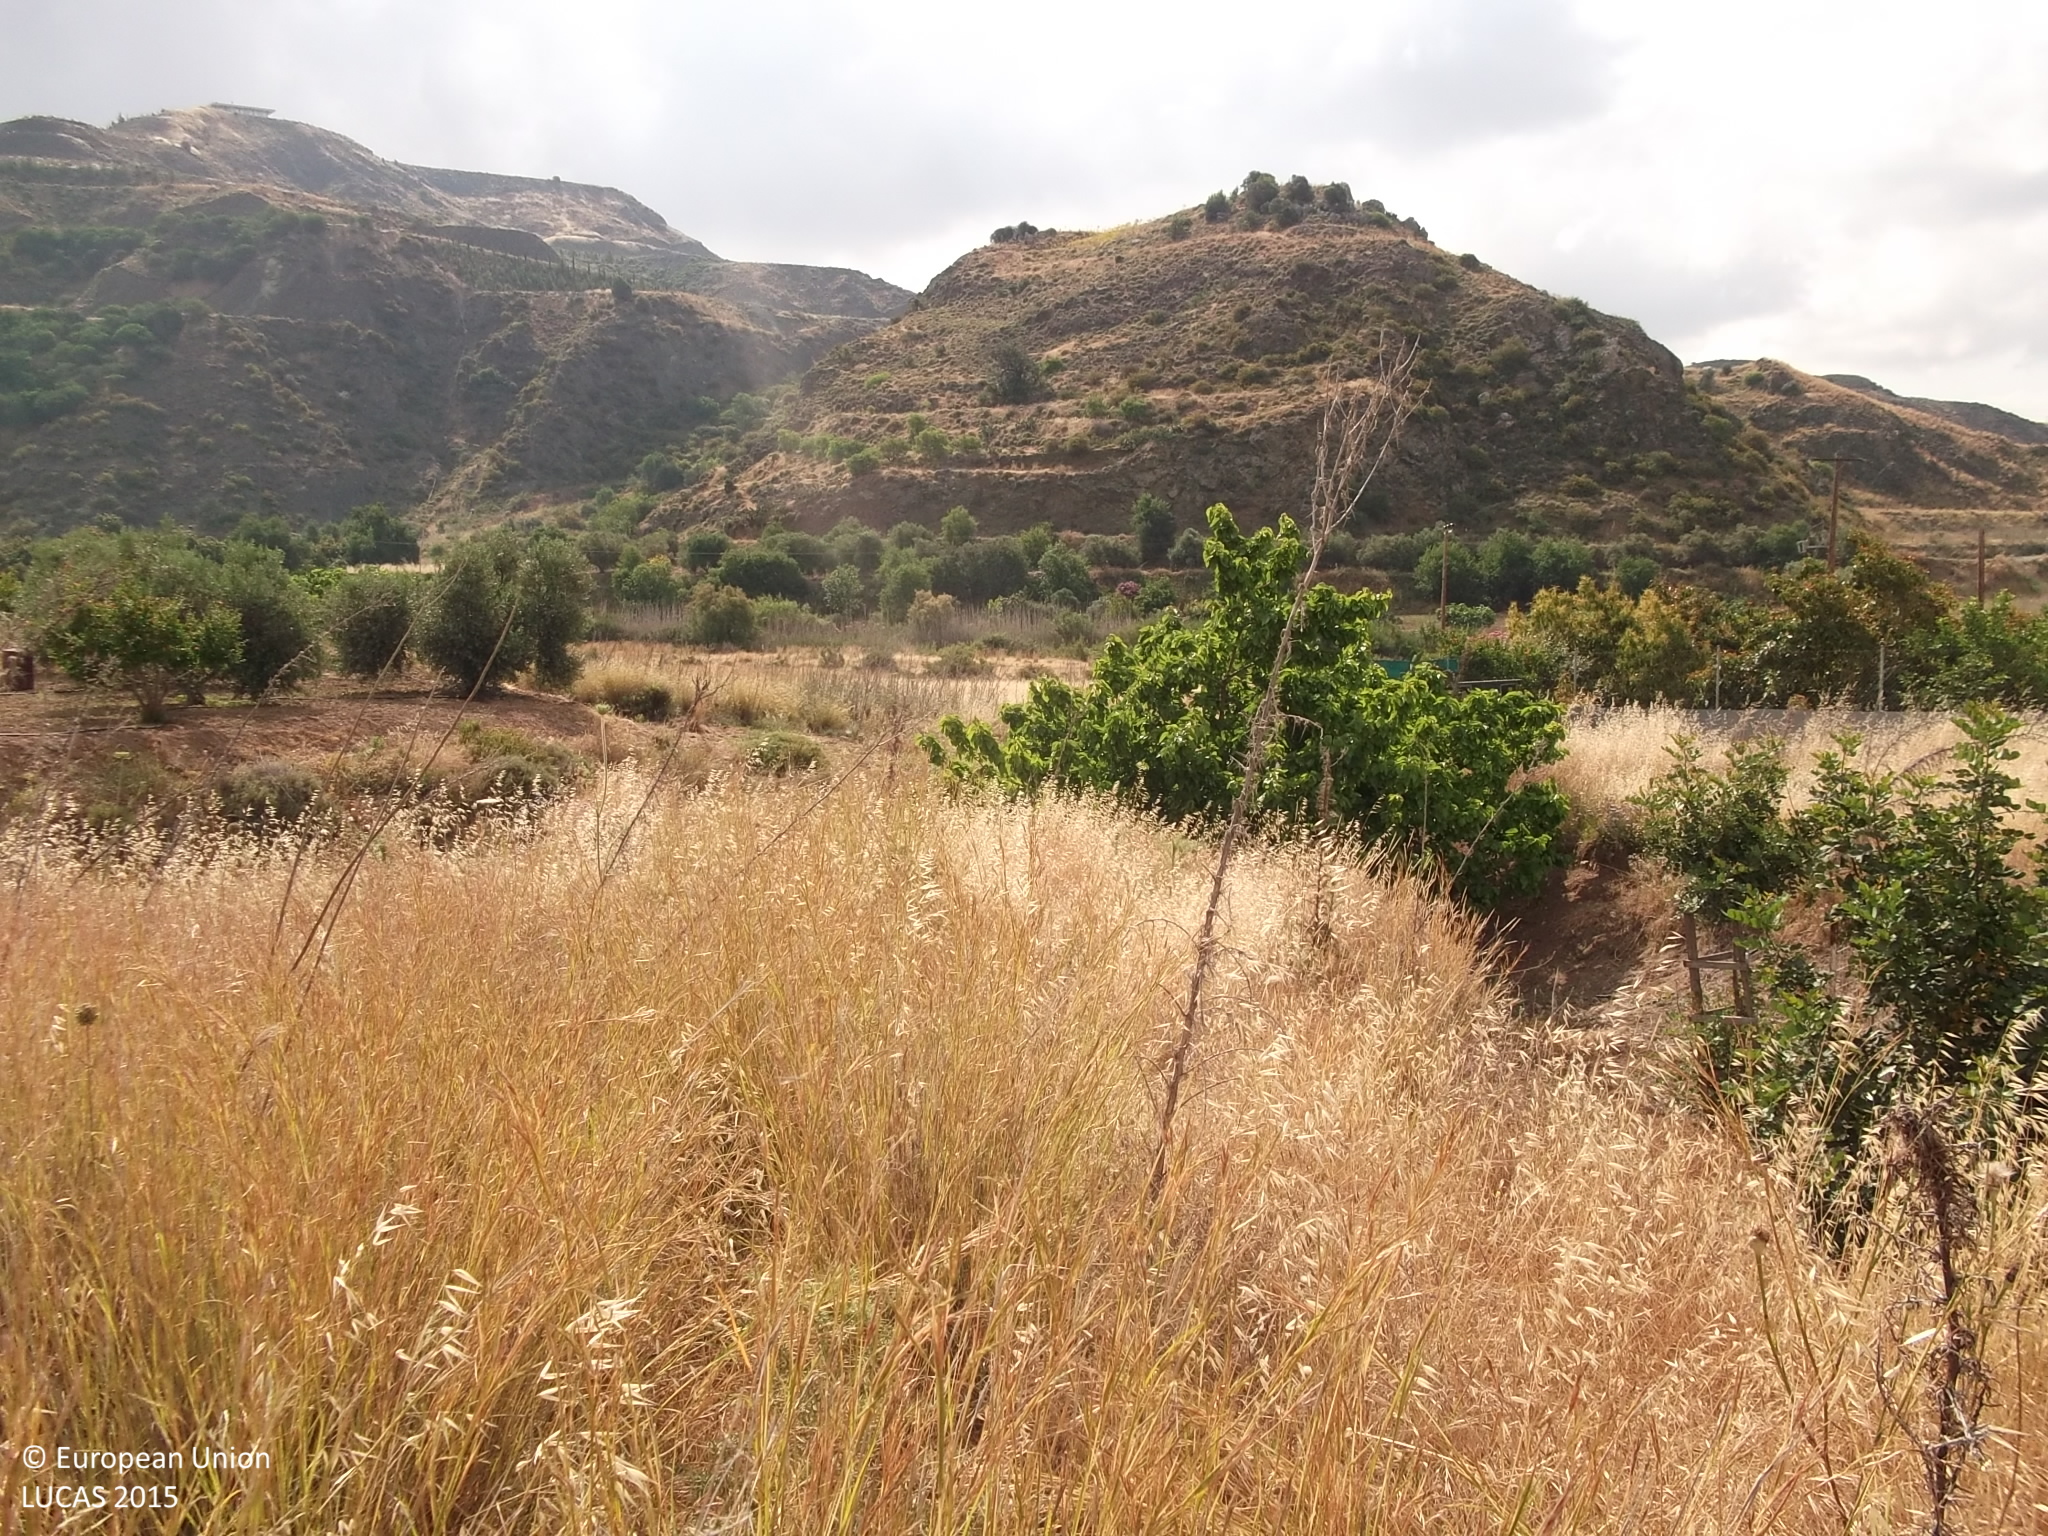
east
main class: Grassland
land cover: Grassland without tree/shrub cover
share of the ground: > 75 %
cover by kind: herbaceous plants 100 %
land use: Semi-natural and natural areas not in use
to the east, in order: Grassland without tree/shrub cover; Olive groves; Shrubland without tree cover; Tracks; Shrubland without tree cover; Electric lines; Shrubland without tree cover; Tracks; Shrubland with sparse tree cover; Inland fresh running water; Broadleaved woodland; Other fruit trees and berries
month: May
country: CY
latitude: 34.7672
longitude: 32.5131
